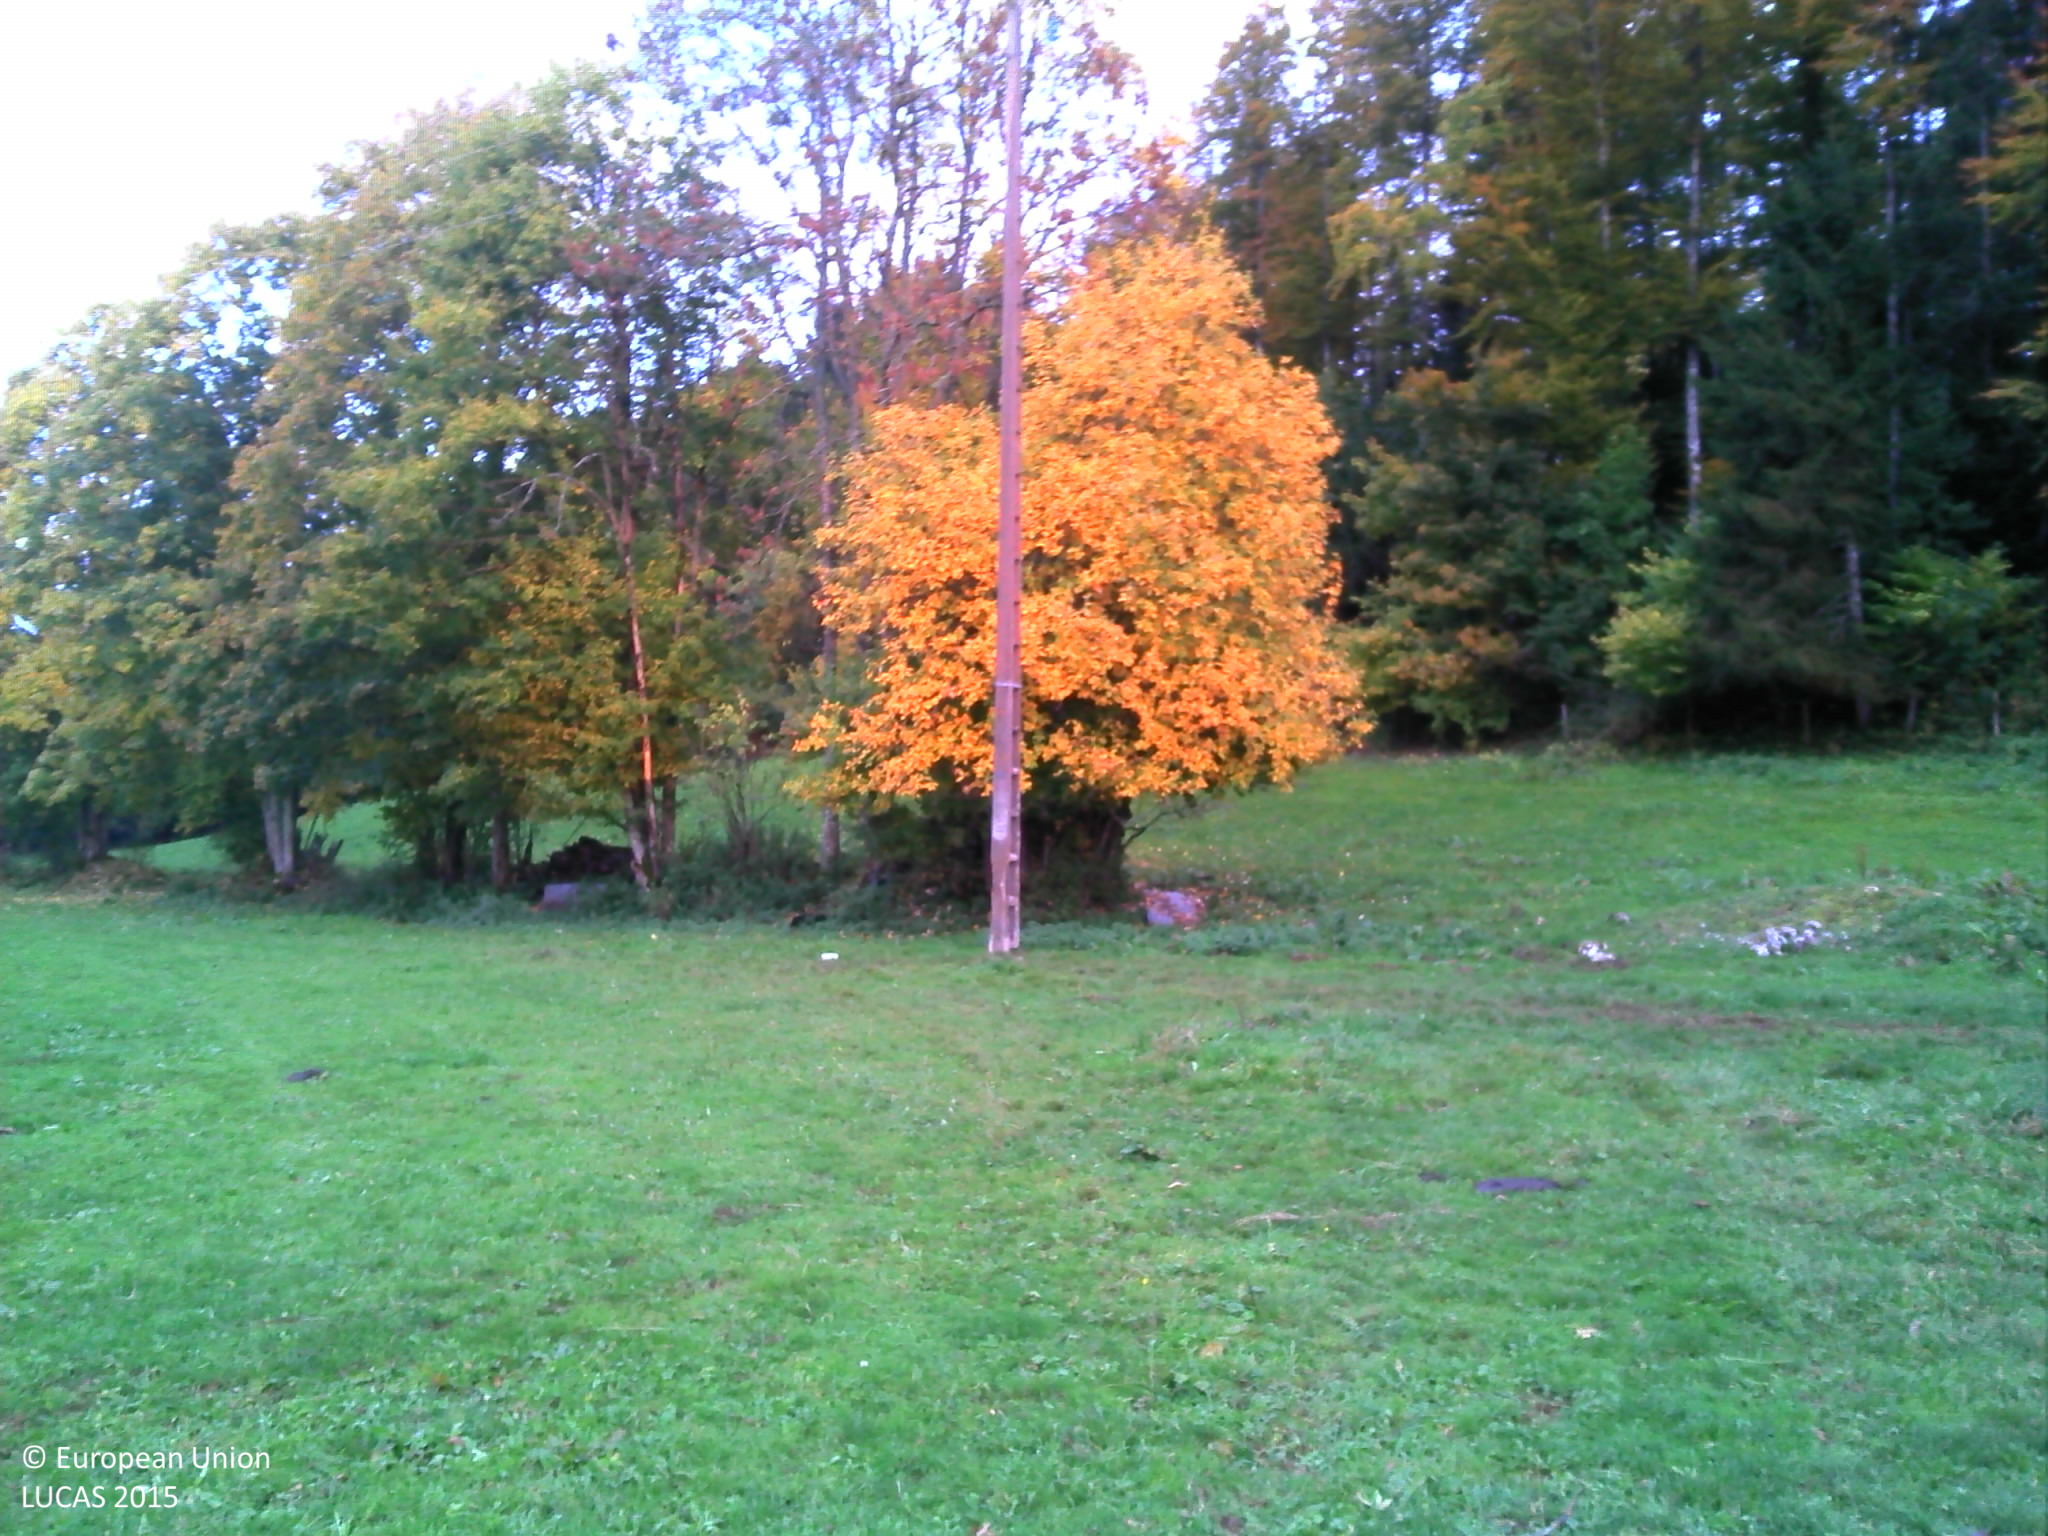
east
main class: Grassland
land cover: Grassland without tree/shrub cover
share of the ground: > 75 %
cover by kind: herbaceous plants 100 %
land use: Agriculture (excluding fallow land and kitchen gardens)
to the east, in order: Grassland without tree/shrub cover; Electric lines; Grassland without tree/shrub cover; Broadleaved woodland; Grassland without tree/shrub cover; Fences; Spruce dominated mixed woodland; Dry stone walls; Spruce dominated mixed woodland
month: October
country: FR
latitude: 46.8296
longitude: 6.3449
